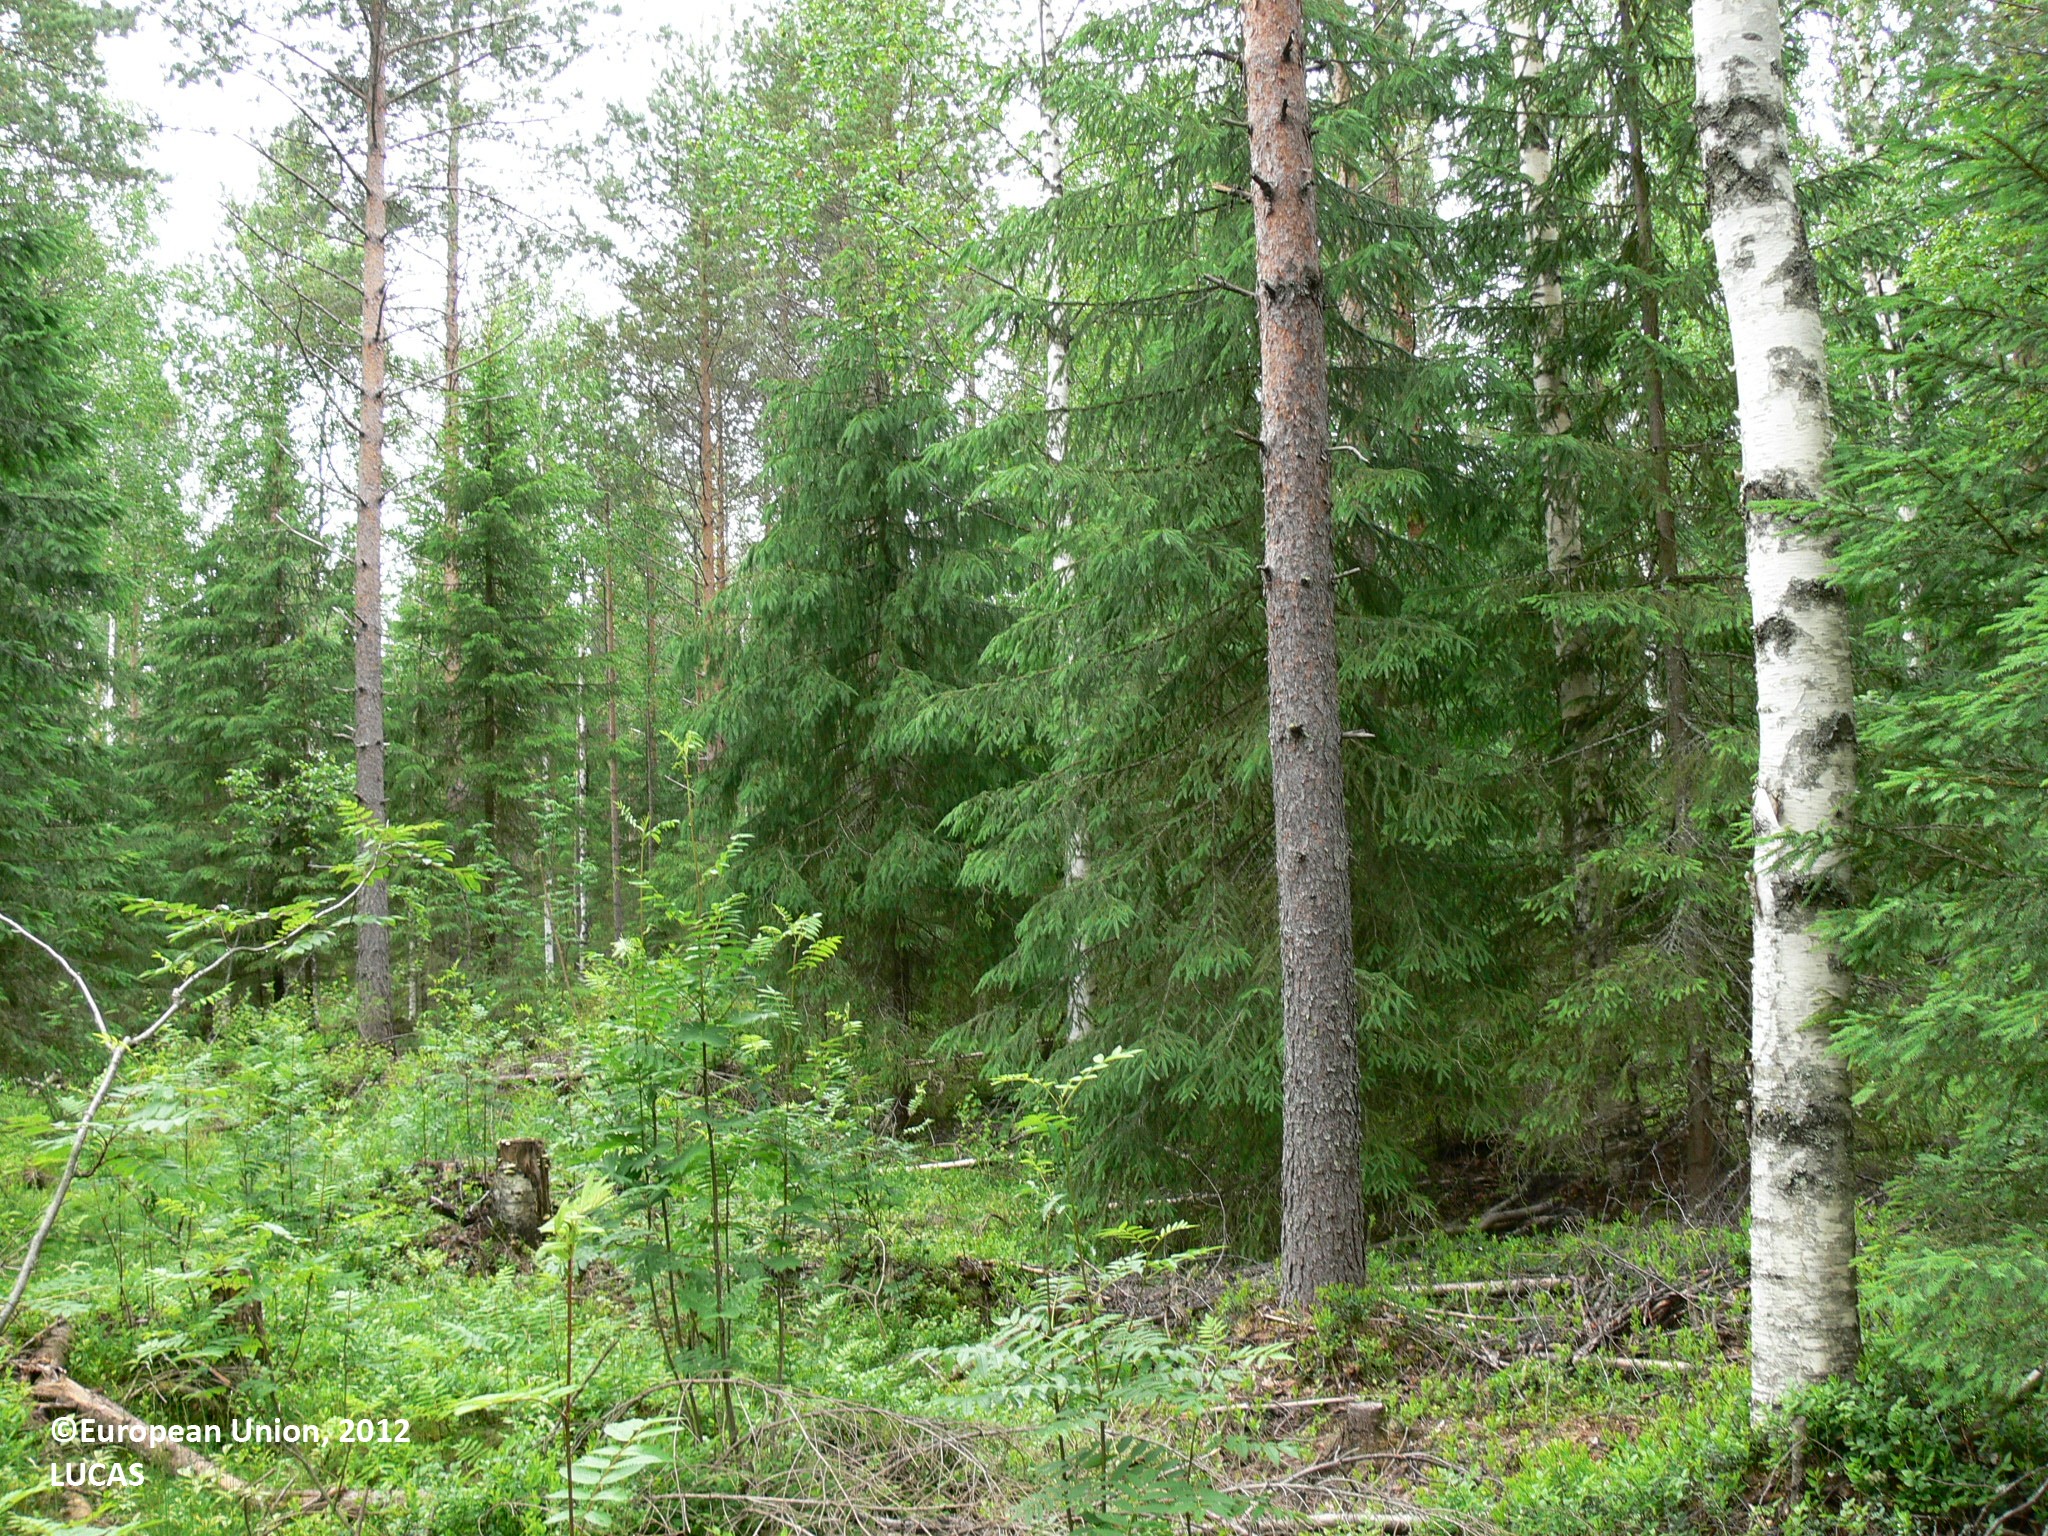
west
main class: Woodland
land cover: Other mixed woodland
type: boreal forest
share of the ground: > 75 %
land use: Forestry
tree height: > 5 m
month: June
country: FI
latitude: 62.8732
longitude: 29.3161
